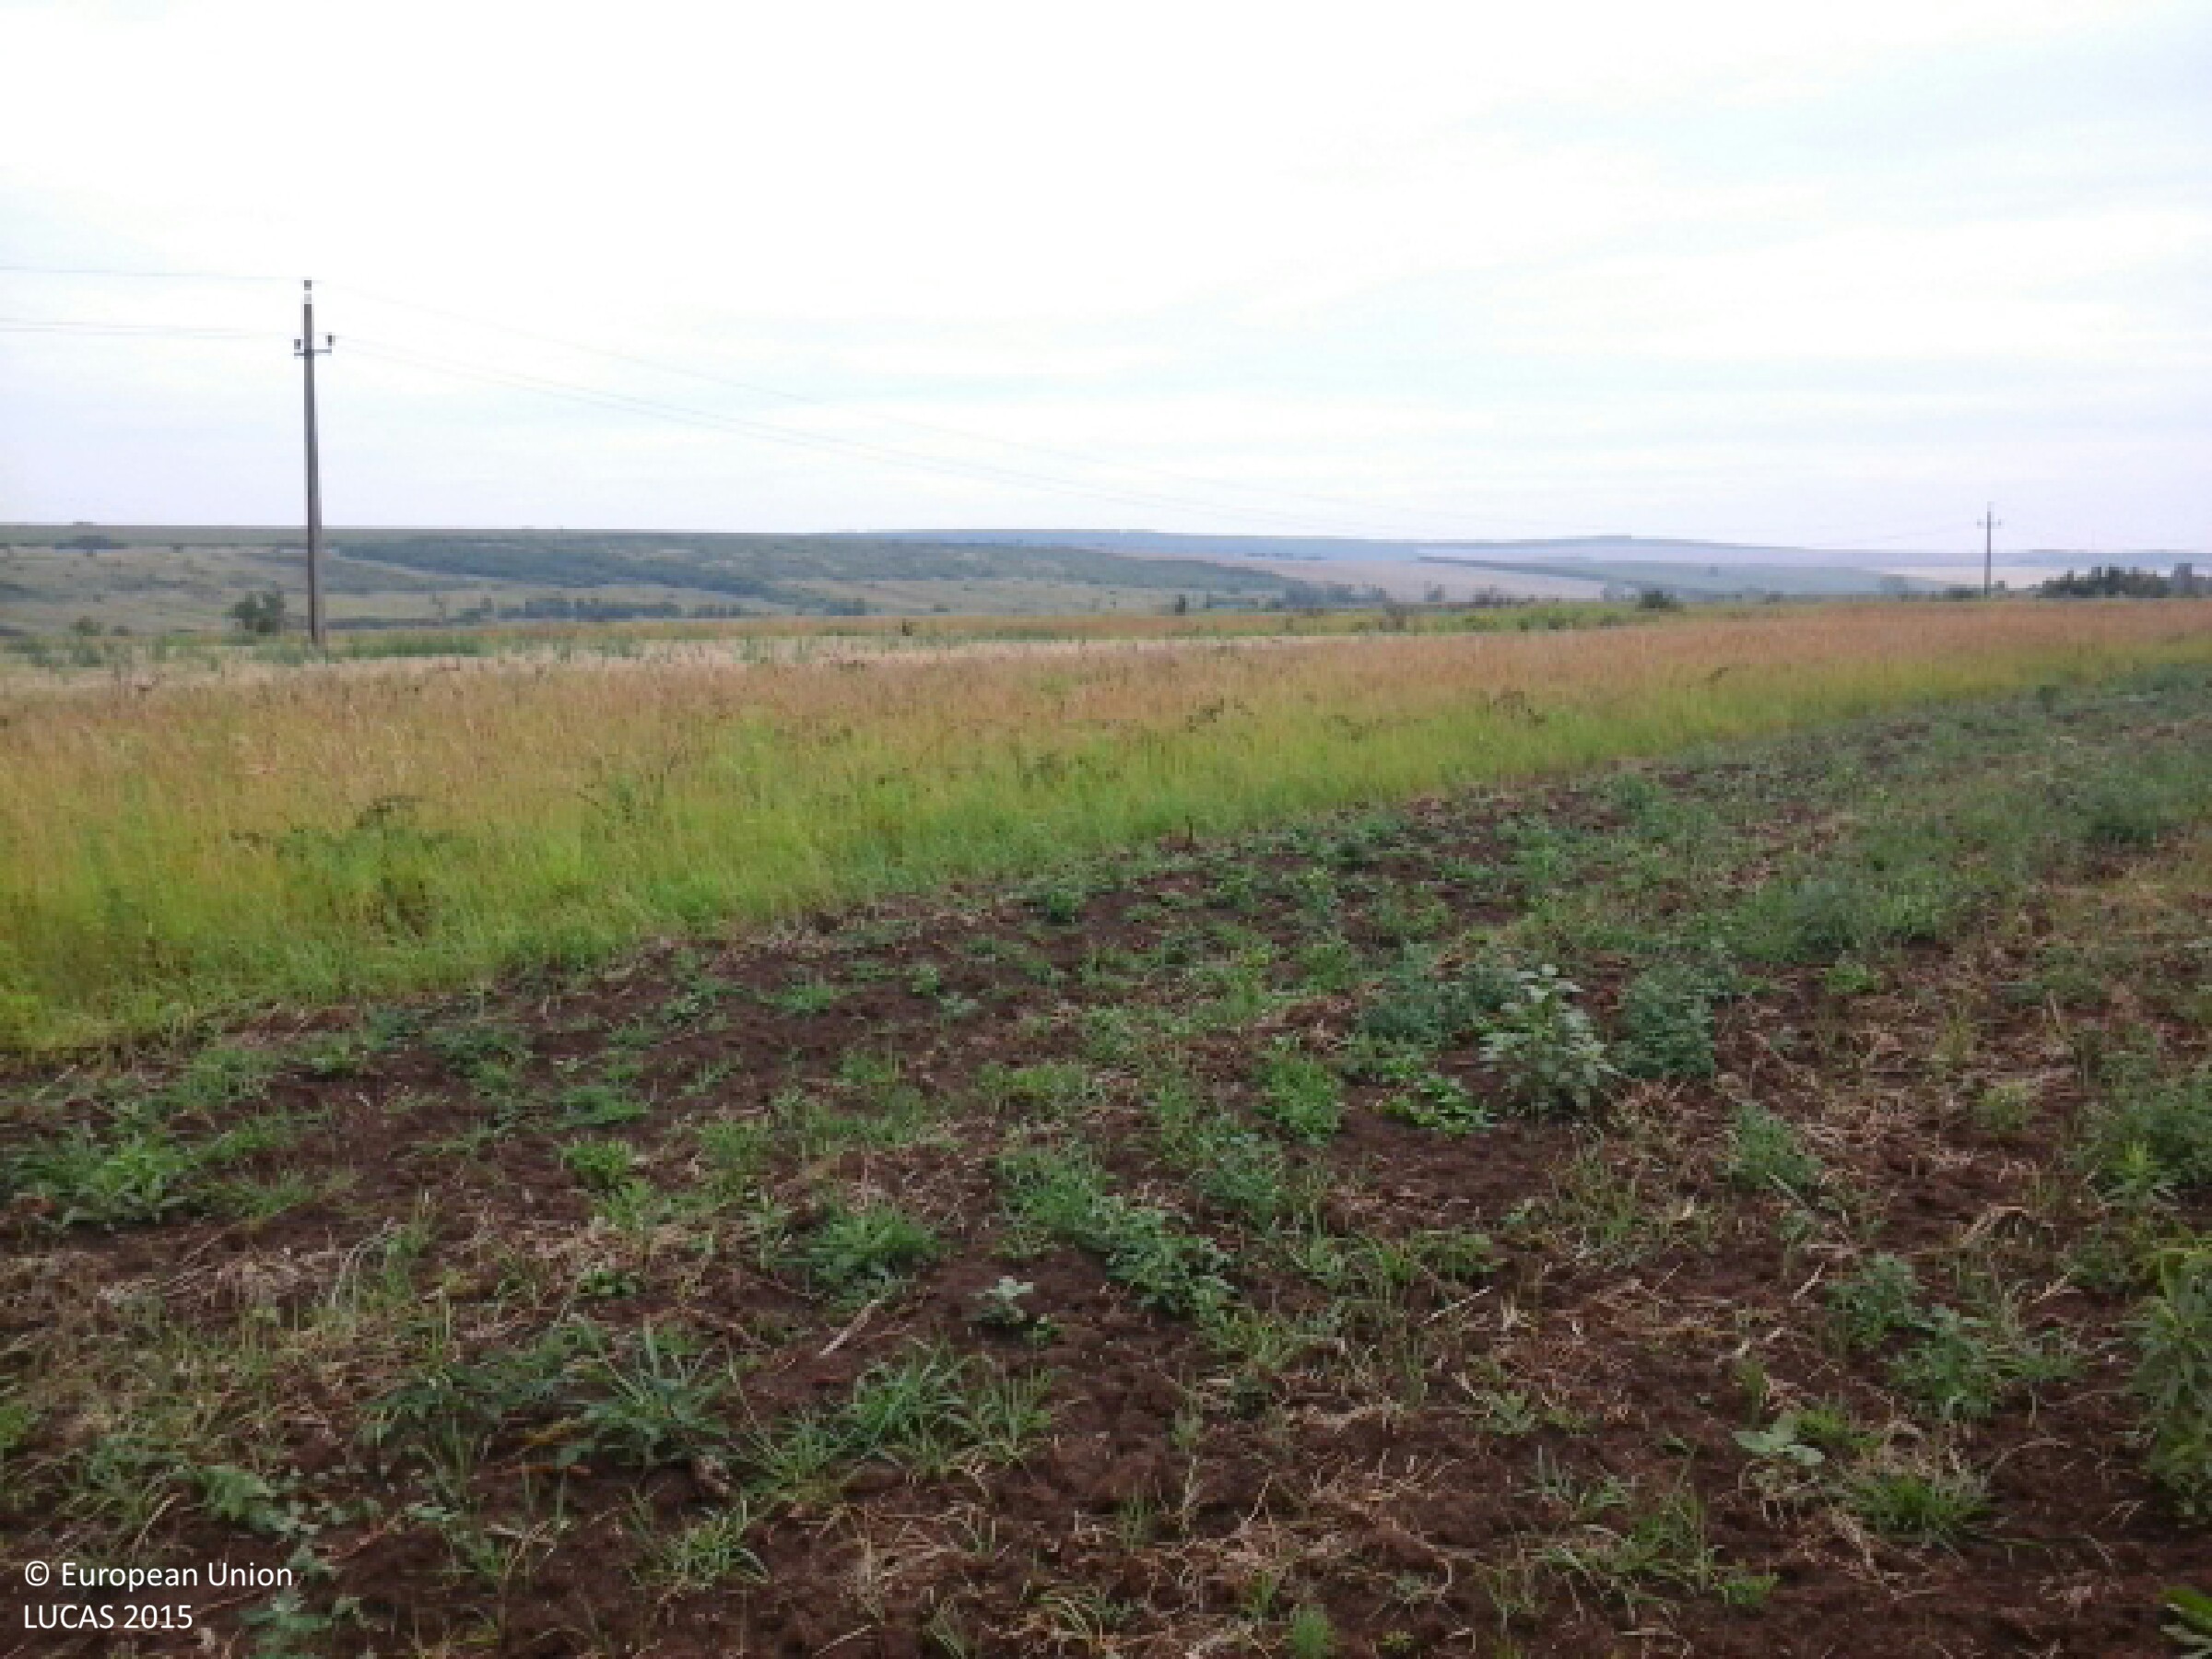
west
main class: Grassland
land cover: Spontaneously vegetated surfaces
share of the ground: 10 - 25 %
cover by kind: herbaceous plants 60 %, consolidated bare surface 40 %
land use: Fallow land
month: July
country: HU
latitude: 48.3342
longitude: 21.0893
